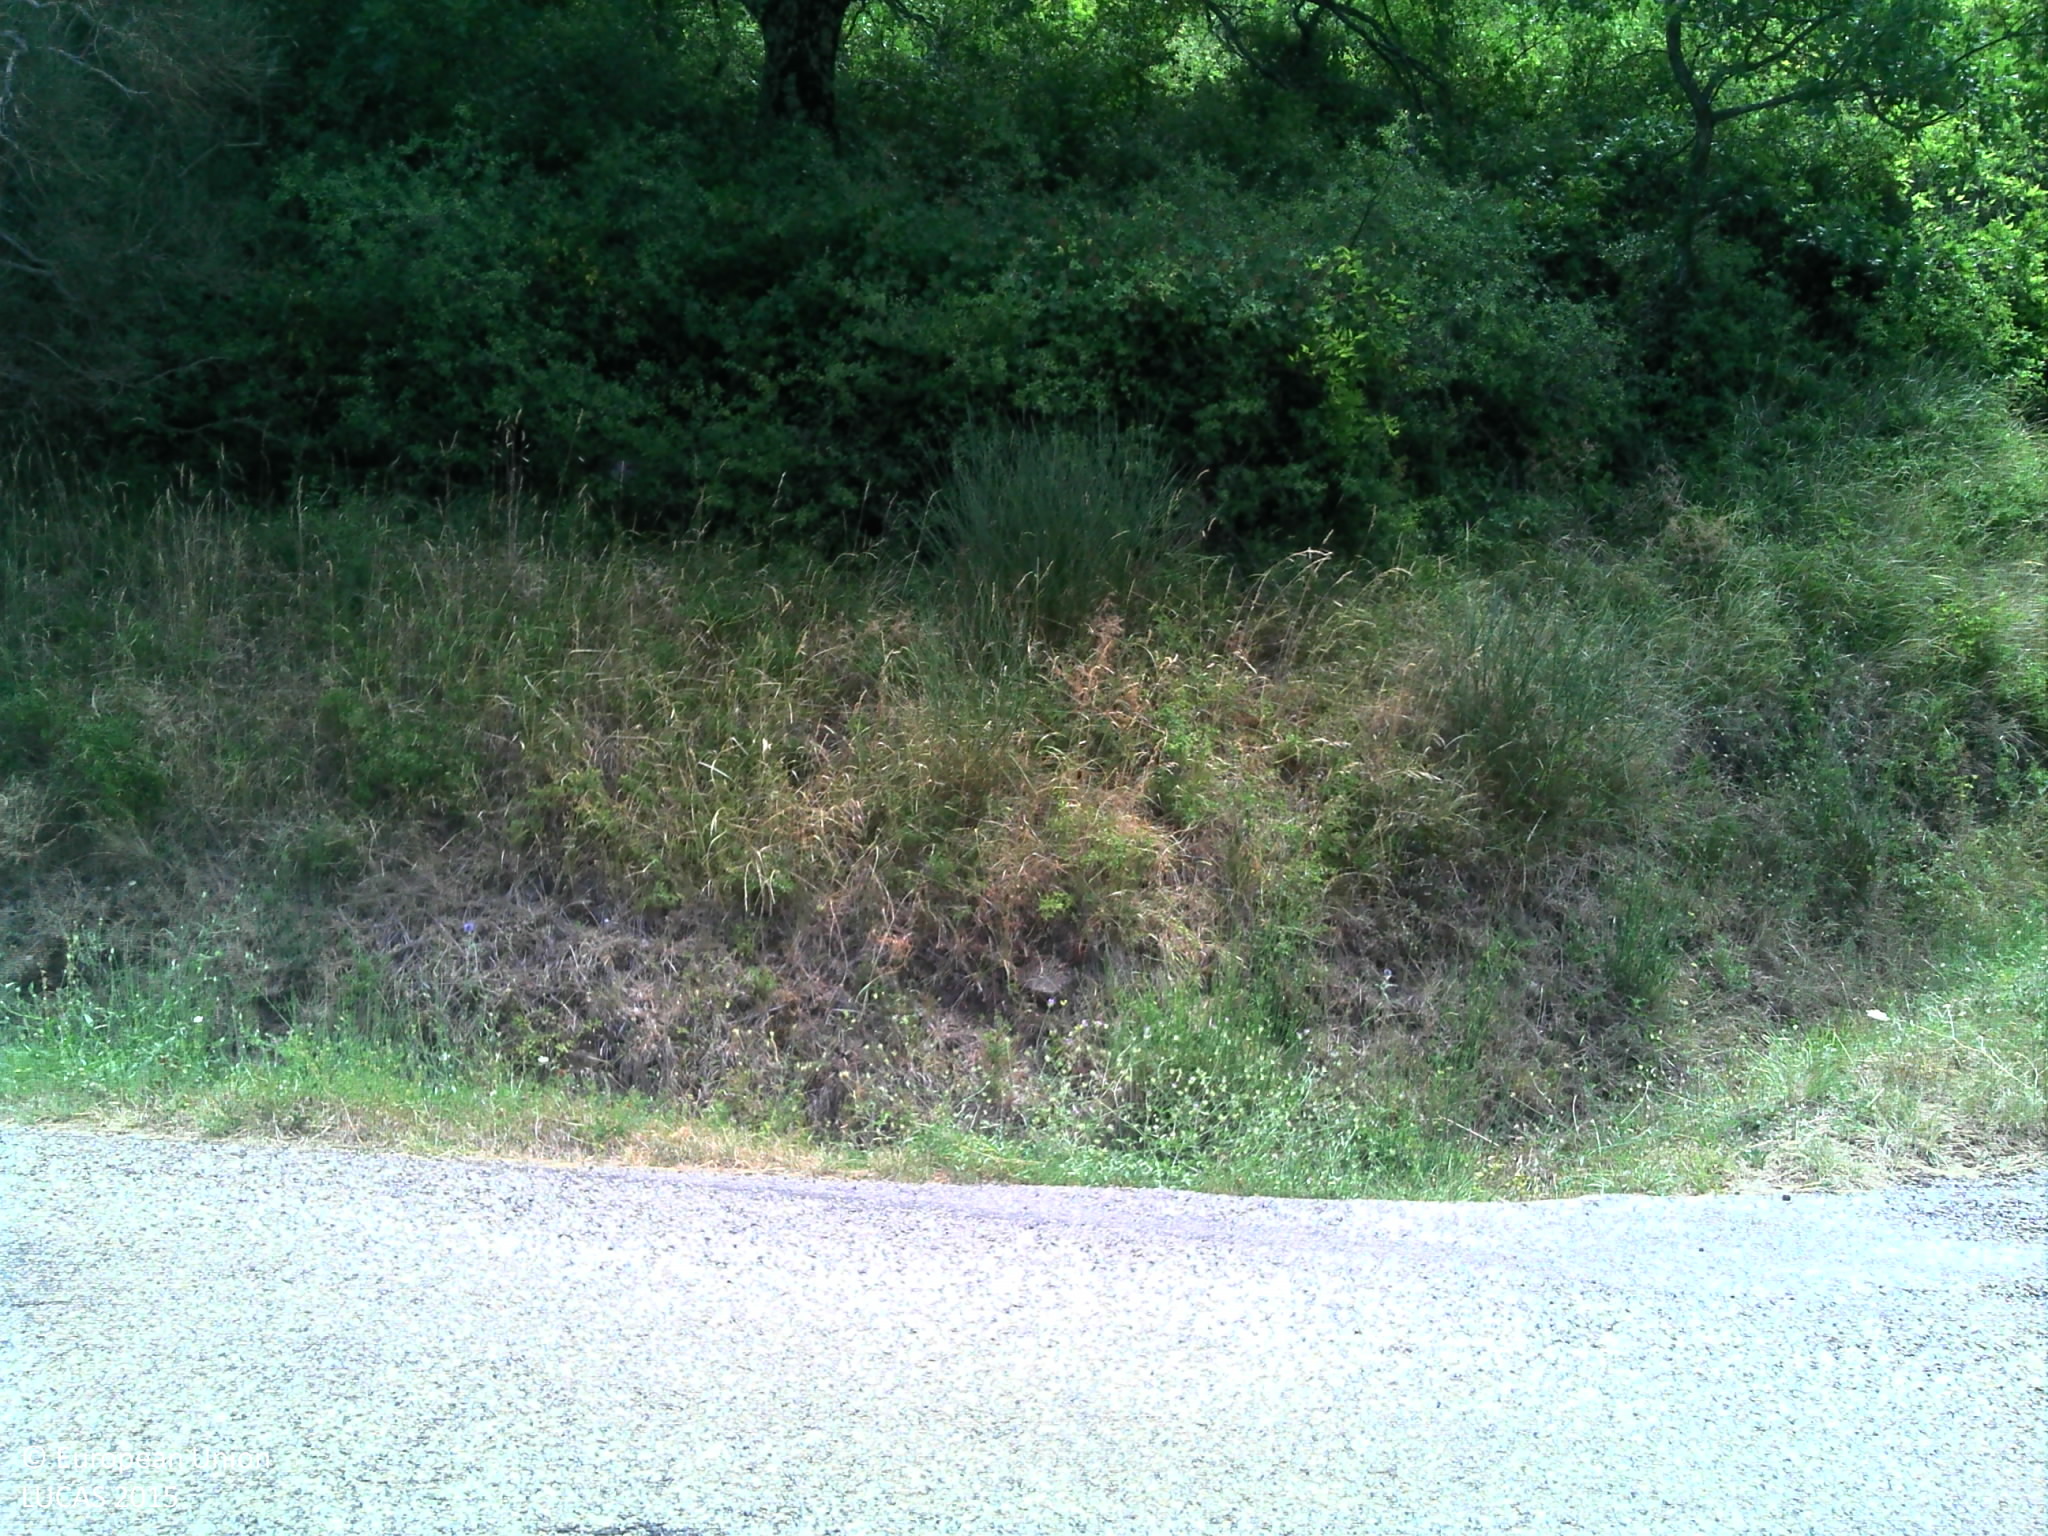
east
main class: Woodland
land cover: Broadleaved woodland
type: broadleaved evergreen forest
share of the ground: > 75 %
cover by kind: broadleaved forest trees 80 %, shrubs 10 %, herbaceous plants 10 %
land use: Semi-natural and natural areas not in use
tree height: > 5 m
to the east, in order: Broadleaved woodland; Rock outcrops; Broadleaved woodland; Grass margins; Paved roads, cycling and walking lanes; Grassland without tree/shrub cover; Paved roads, cycling and walking lanes; Broadleaved woodland
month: July
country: FR
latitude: 44.6076
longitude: 4.6010
